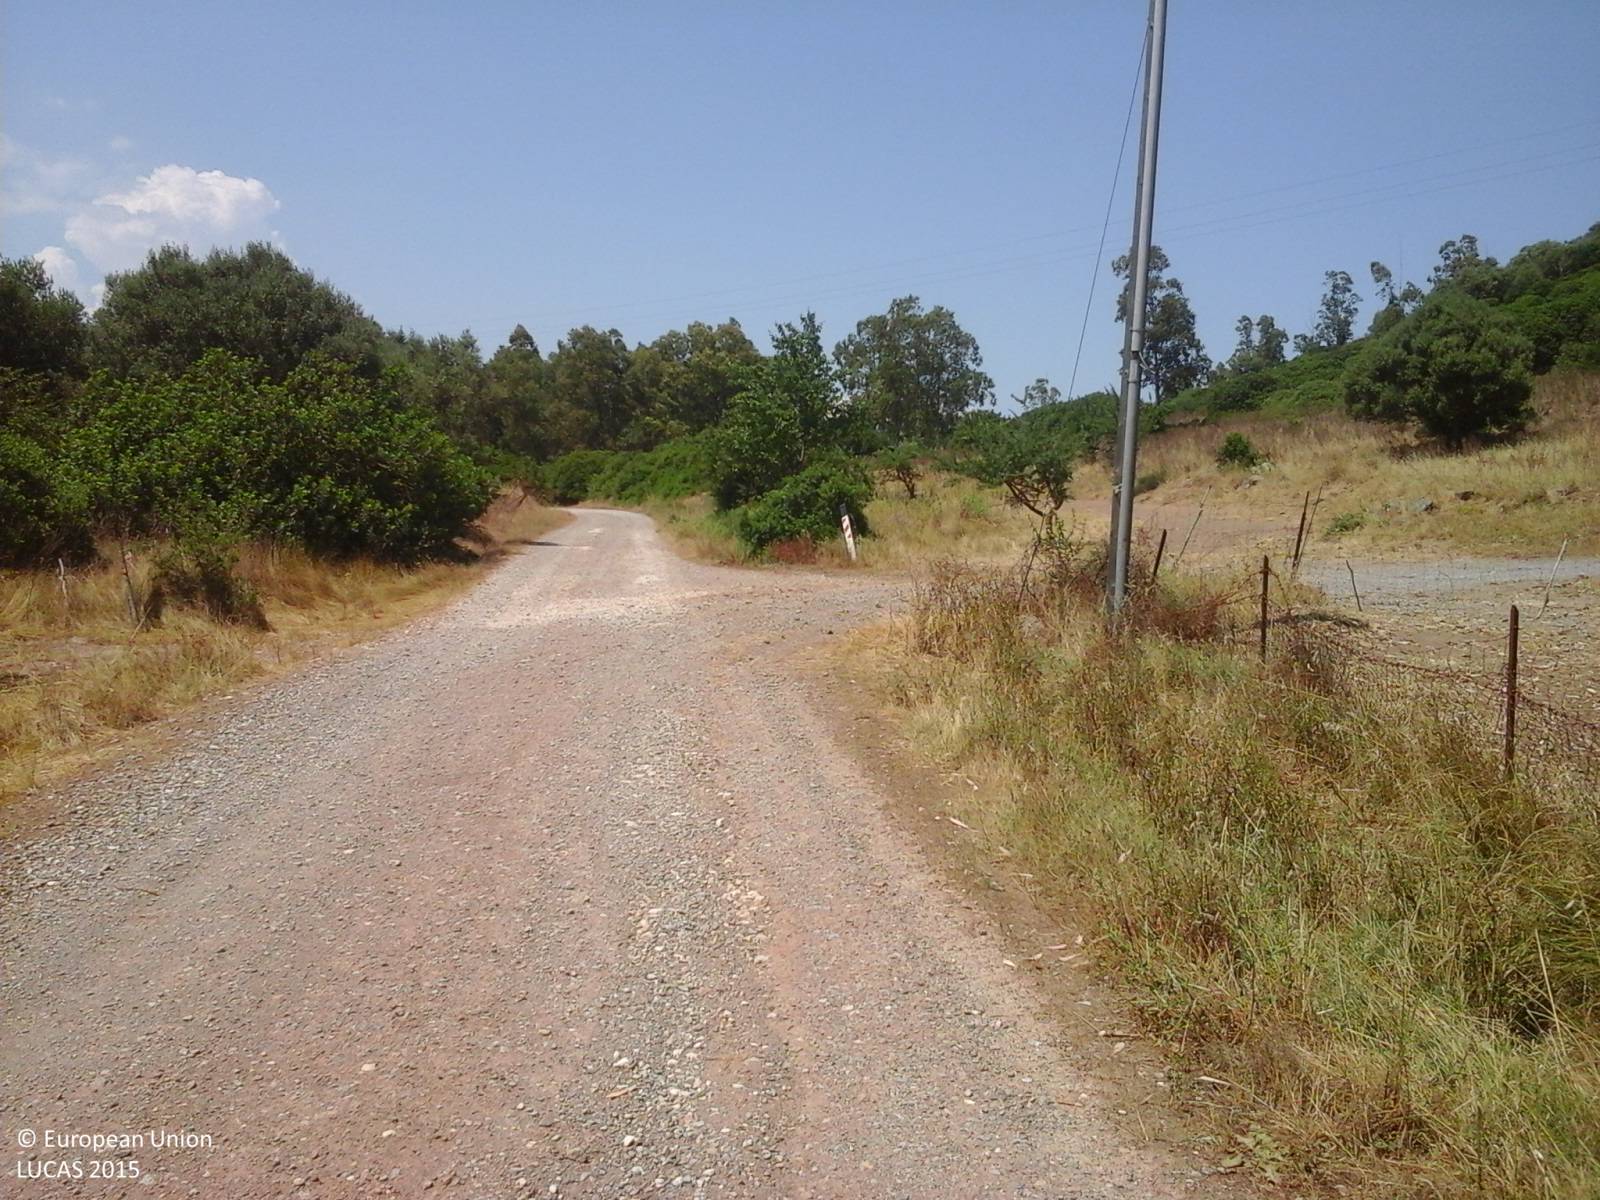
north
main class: Woodland
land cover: Broadleaved woodland
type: broadleaved evergreen forest
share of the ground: > 75 %
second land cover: Grassland without tree/shrub cover
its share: > 75 %
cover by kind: broadleaved forest trees 70 %, shrubs 20 %, herbaceous plants 10 %
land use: Forestry
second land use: Agriculture (excluding fallow land and kitchen gardens)
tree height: > 5 m
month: June
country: IT
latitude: 39.3186
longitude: 8.8356
